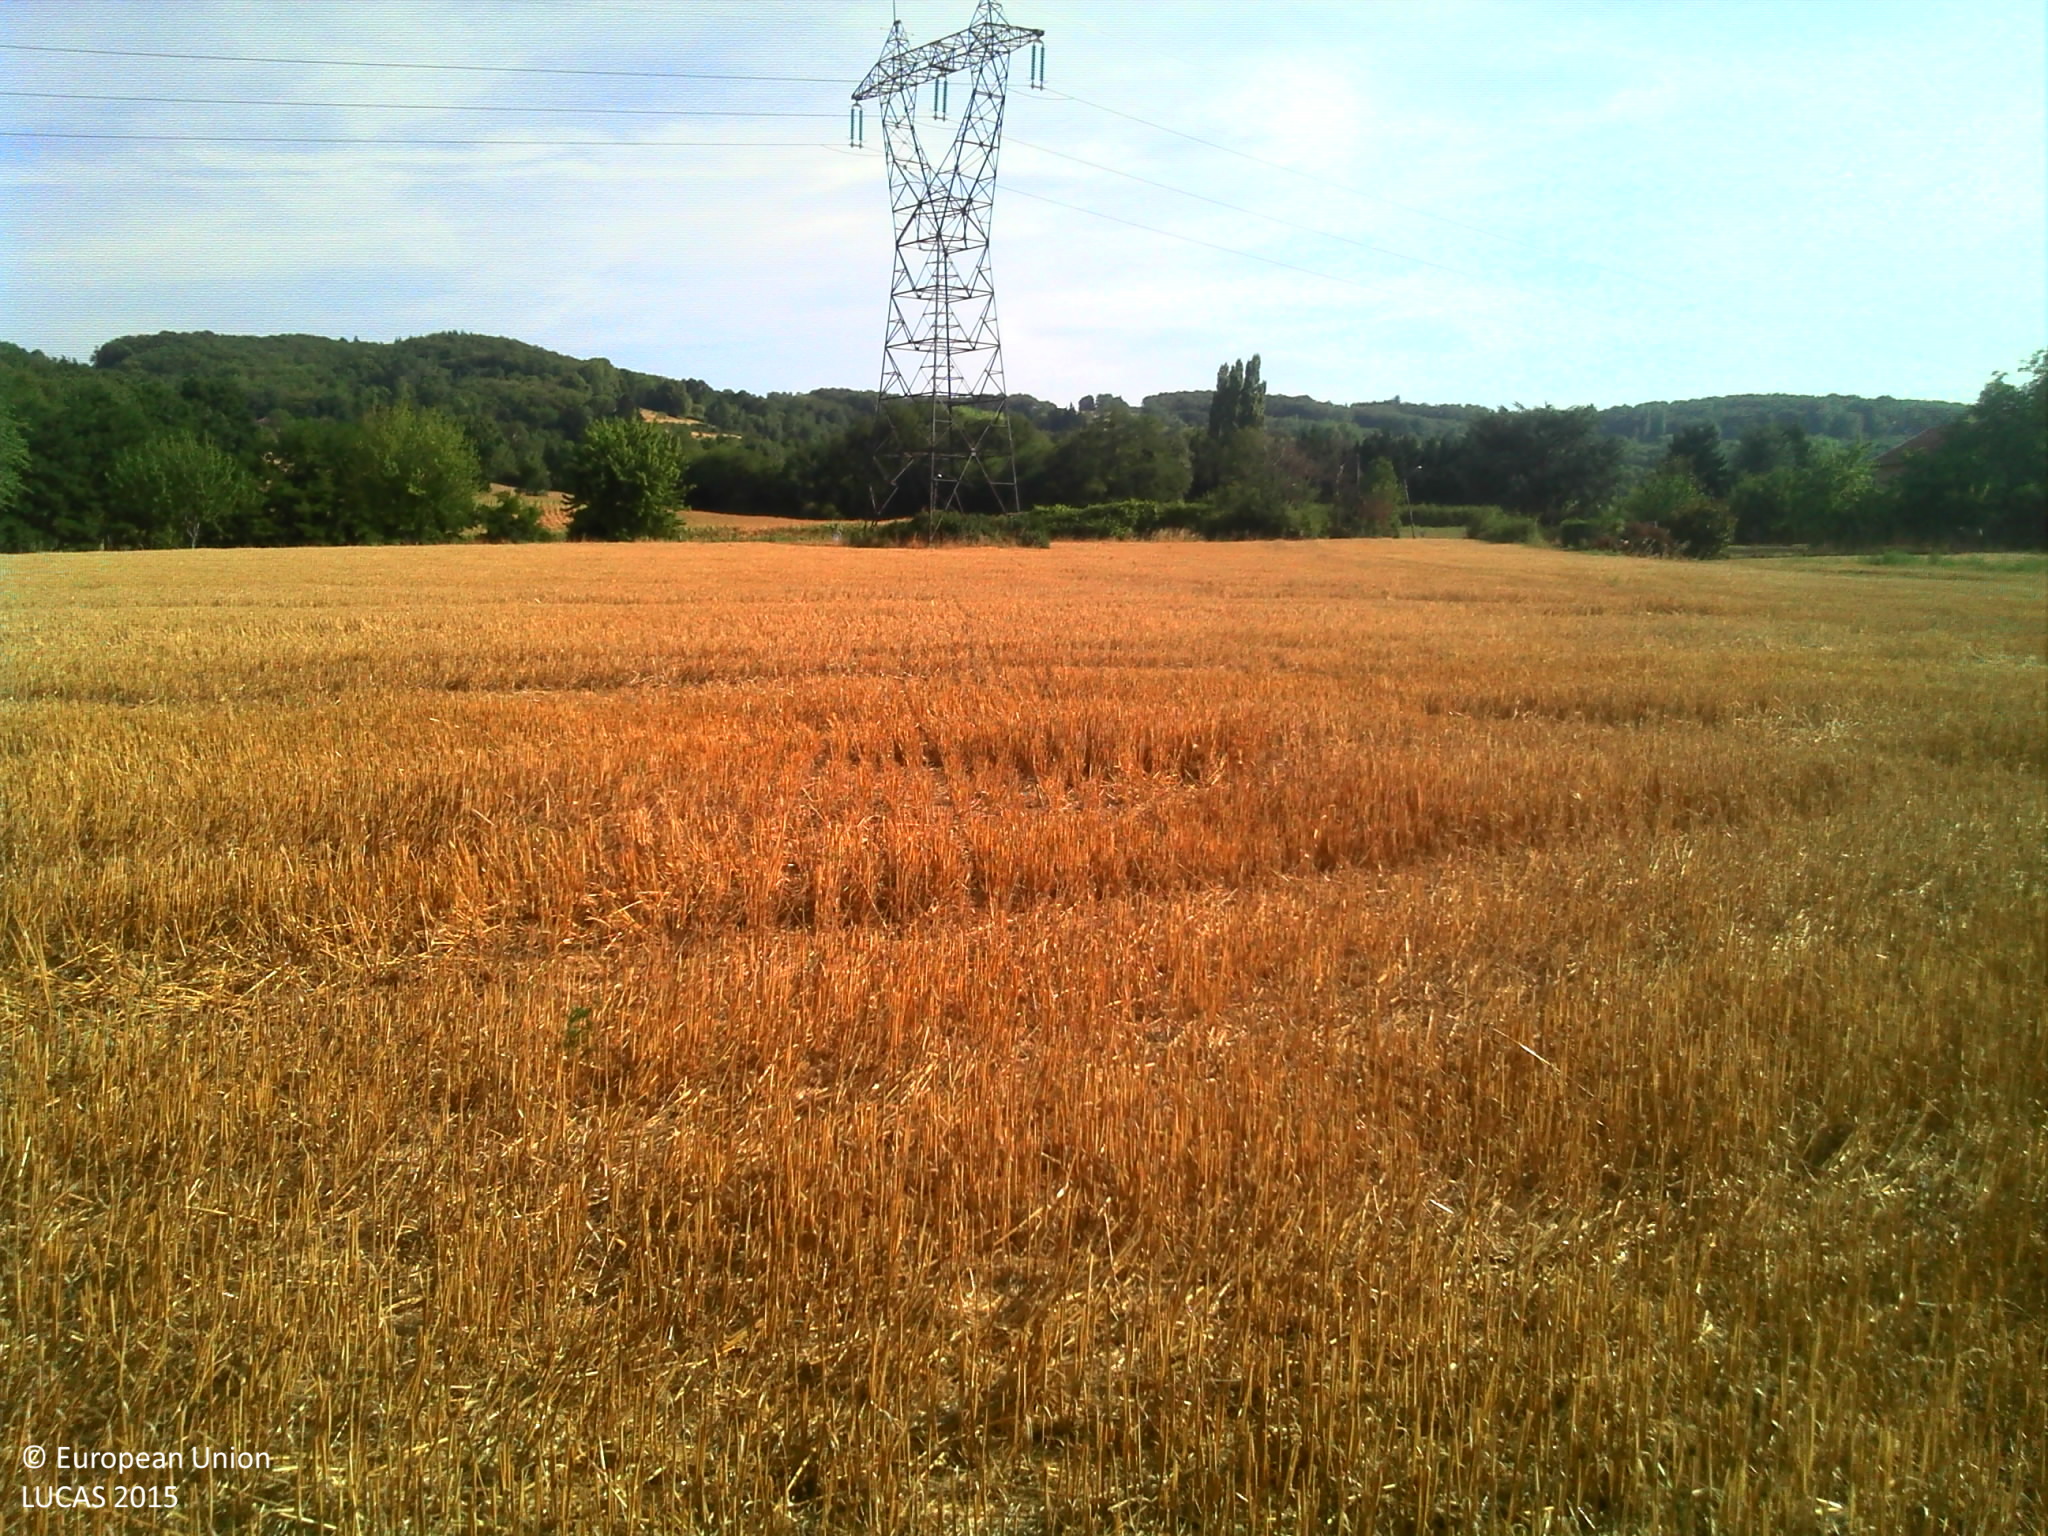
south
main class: Cropland
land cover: Durum wheat
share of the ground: 10 - 25 %
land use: Agriculture (excluding fallow land and kitchen gardens)
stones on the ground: 25 - 50 %
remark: Harvested field
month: August
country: FR
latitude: 45.6153
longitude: 4.8873
